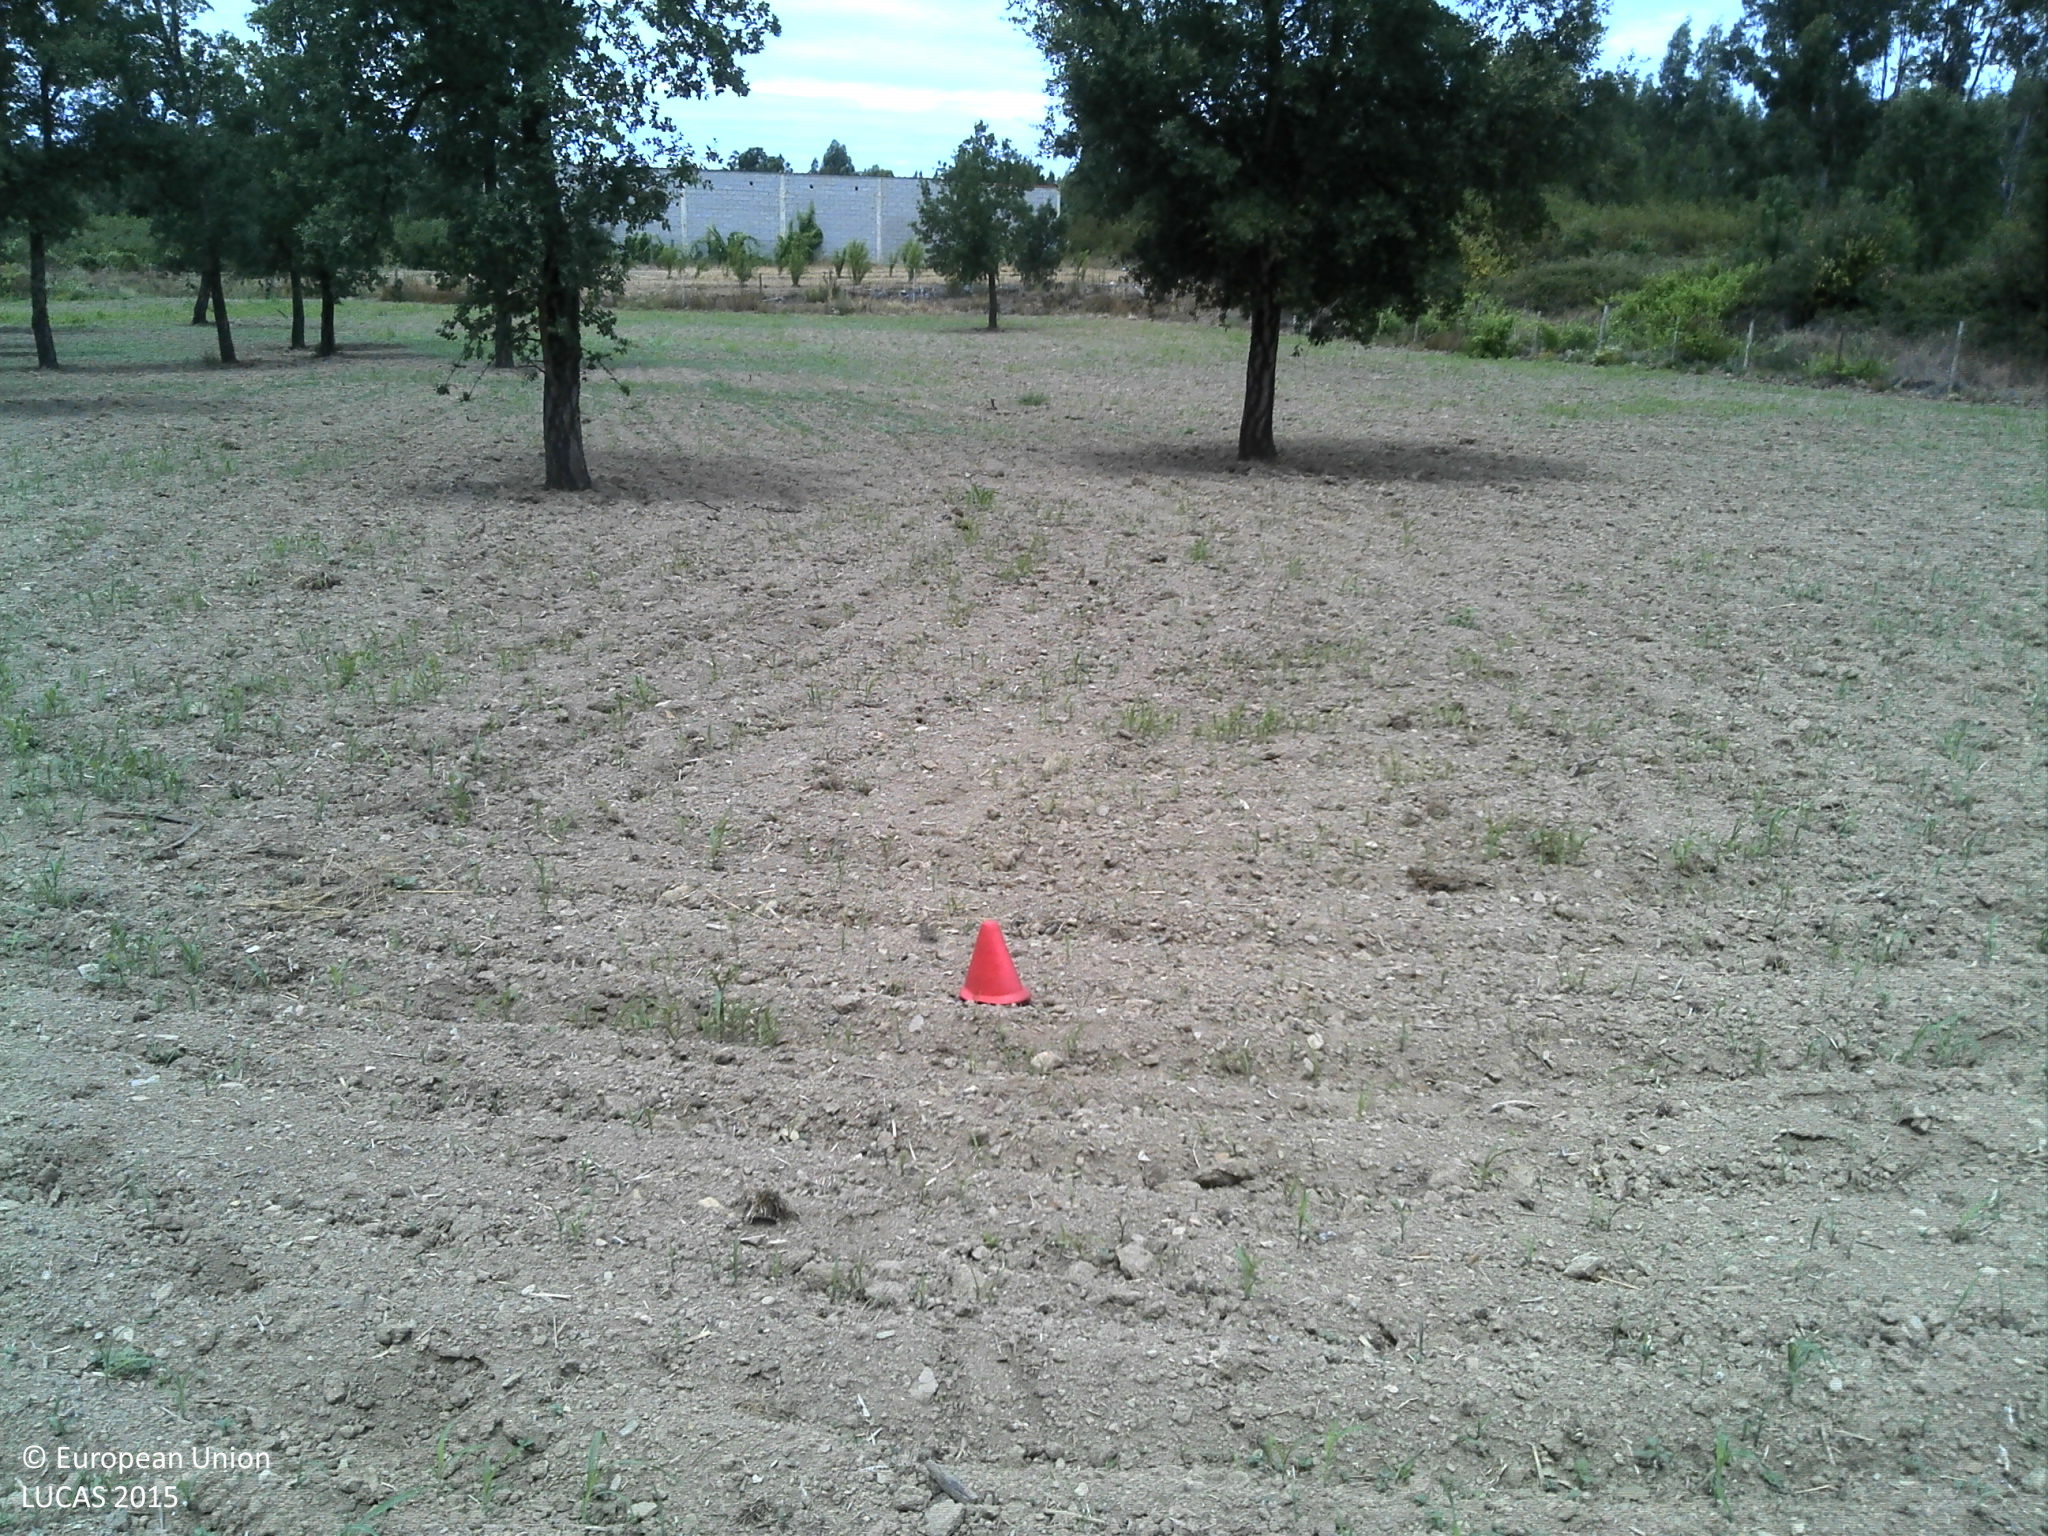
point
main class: Cropland
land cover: Durum wheat
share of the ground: < 10 %
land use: Agriculture (excluding fallow land and kitchen gardens)
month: July
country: PT
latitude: 39.6726
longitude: -8.1236
